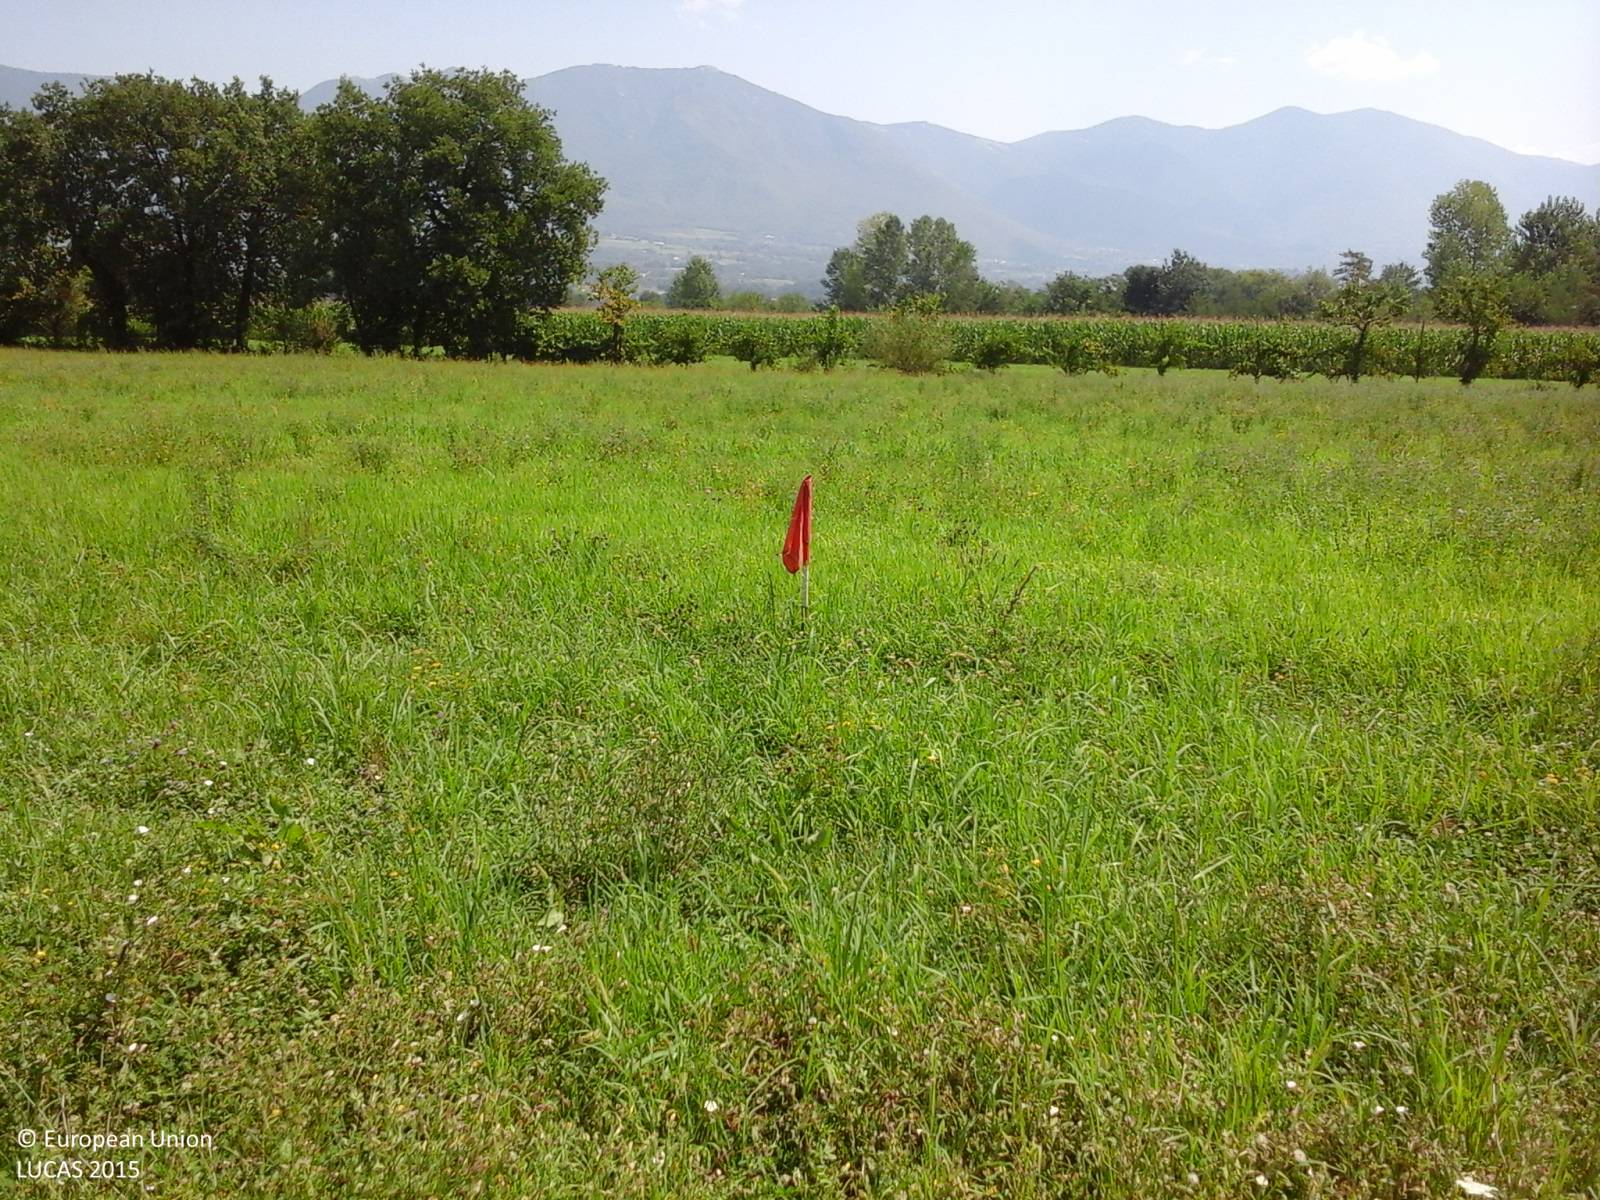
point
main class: Cropland
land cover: Temporary grasslands
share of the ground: > 75 %
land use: Agriculture (excluding fallow land and kitchen gardens)
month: August
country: IT
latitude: 41.3113
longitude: 14.3673
